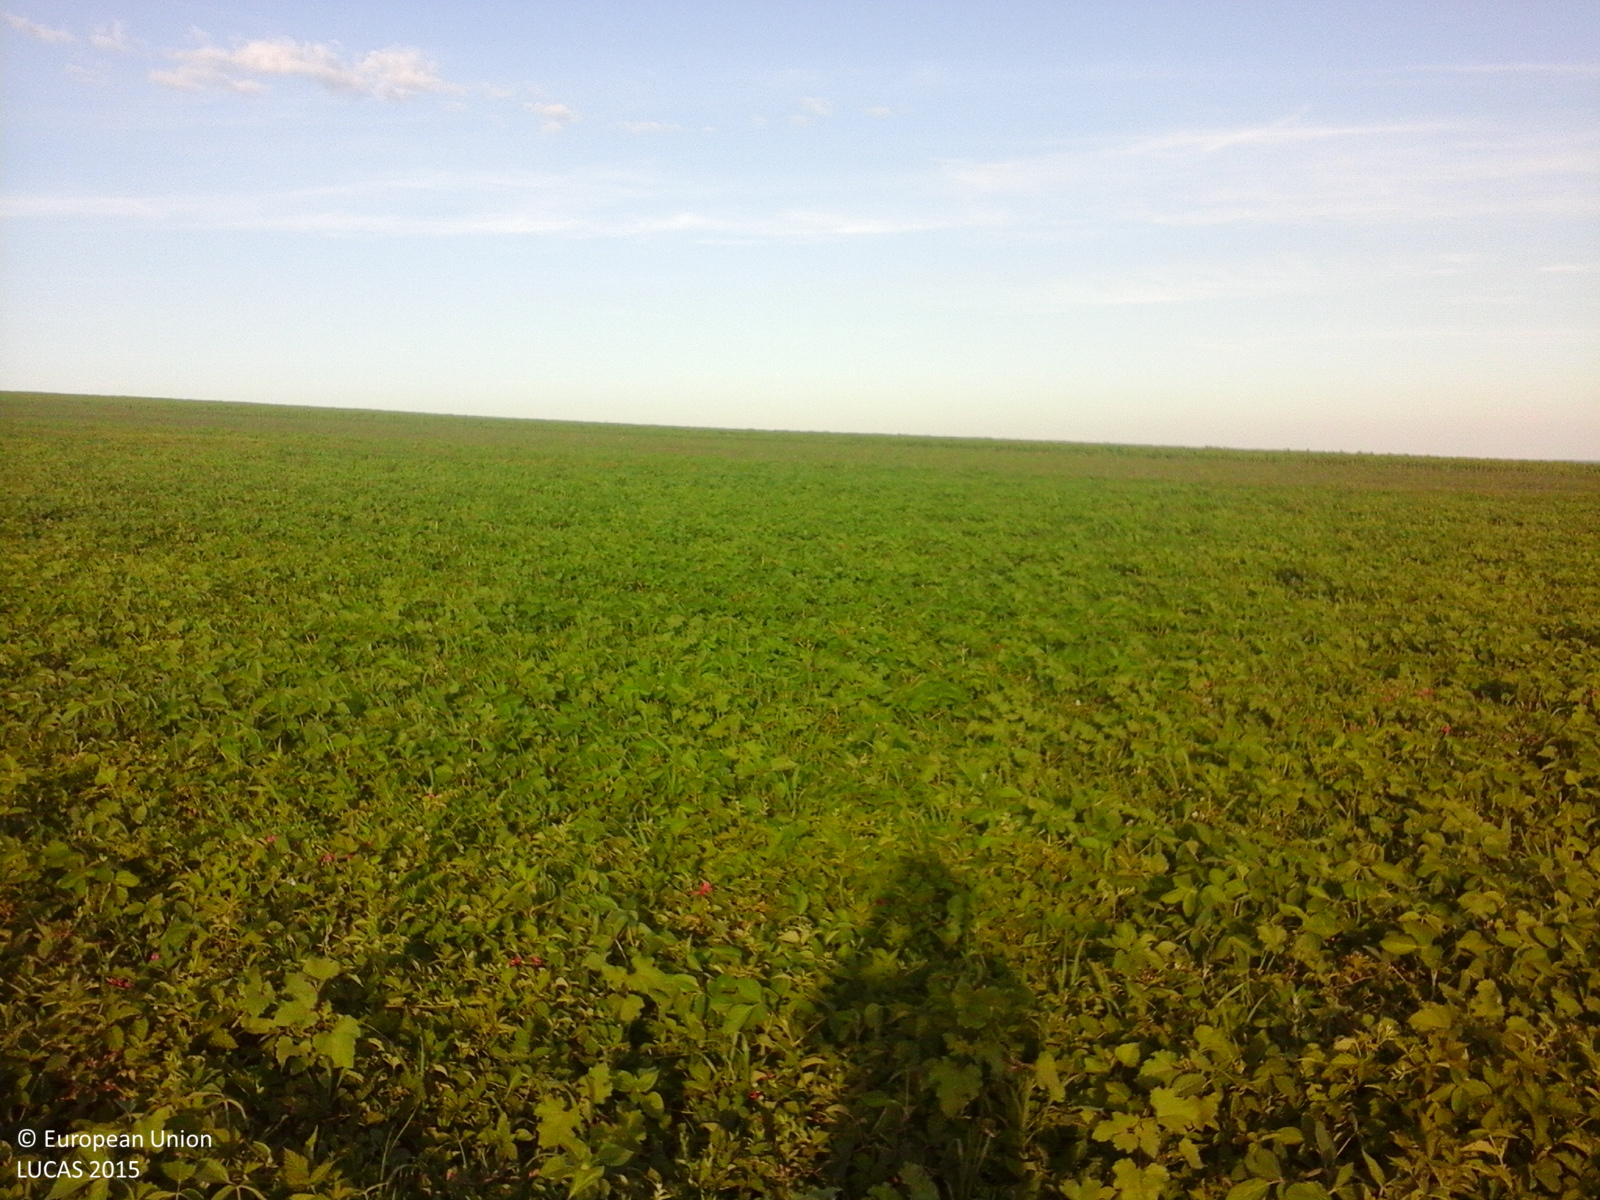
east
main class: Cropland
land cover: Soya
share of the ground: > 75 %
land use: Agriculture (excluding fallow land and kitchen gardens)
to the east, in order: Soya; Maize; Sunflower
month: June
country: RO
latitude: 48.1033
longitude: 26.7660
